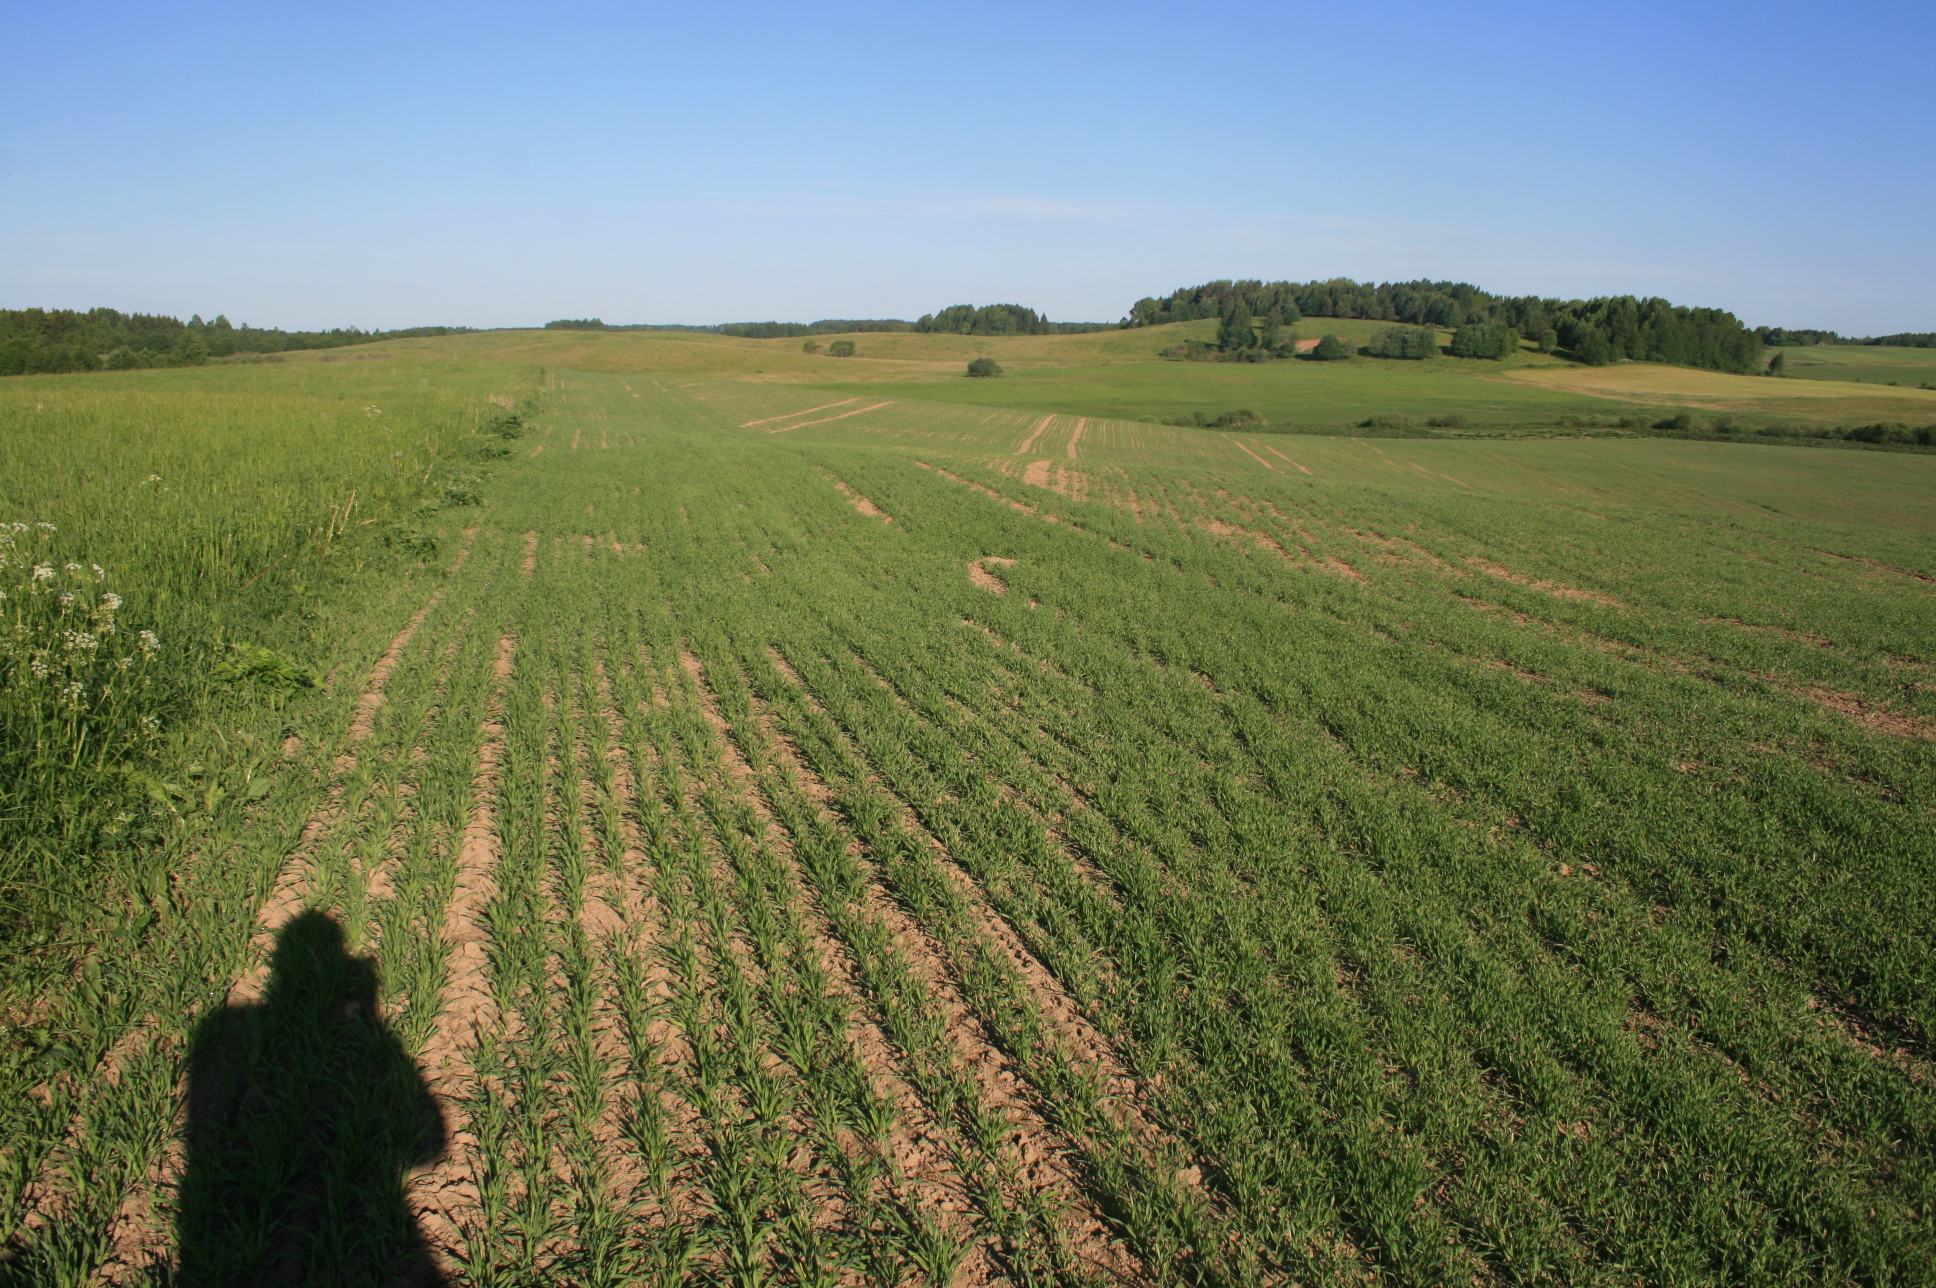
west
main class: Cropland
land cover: Barley
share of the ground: > 75 %
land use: Agriculture (excluding fallow land and kitchen gardens)
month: June
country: LT
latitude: 55.9131
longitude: 22.0028
